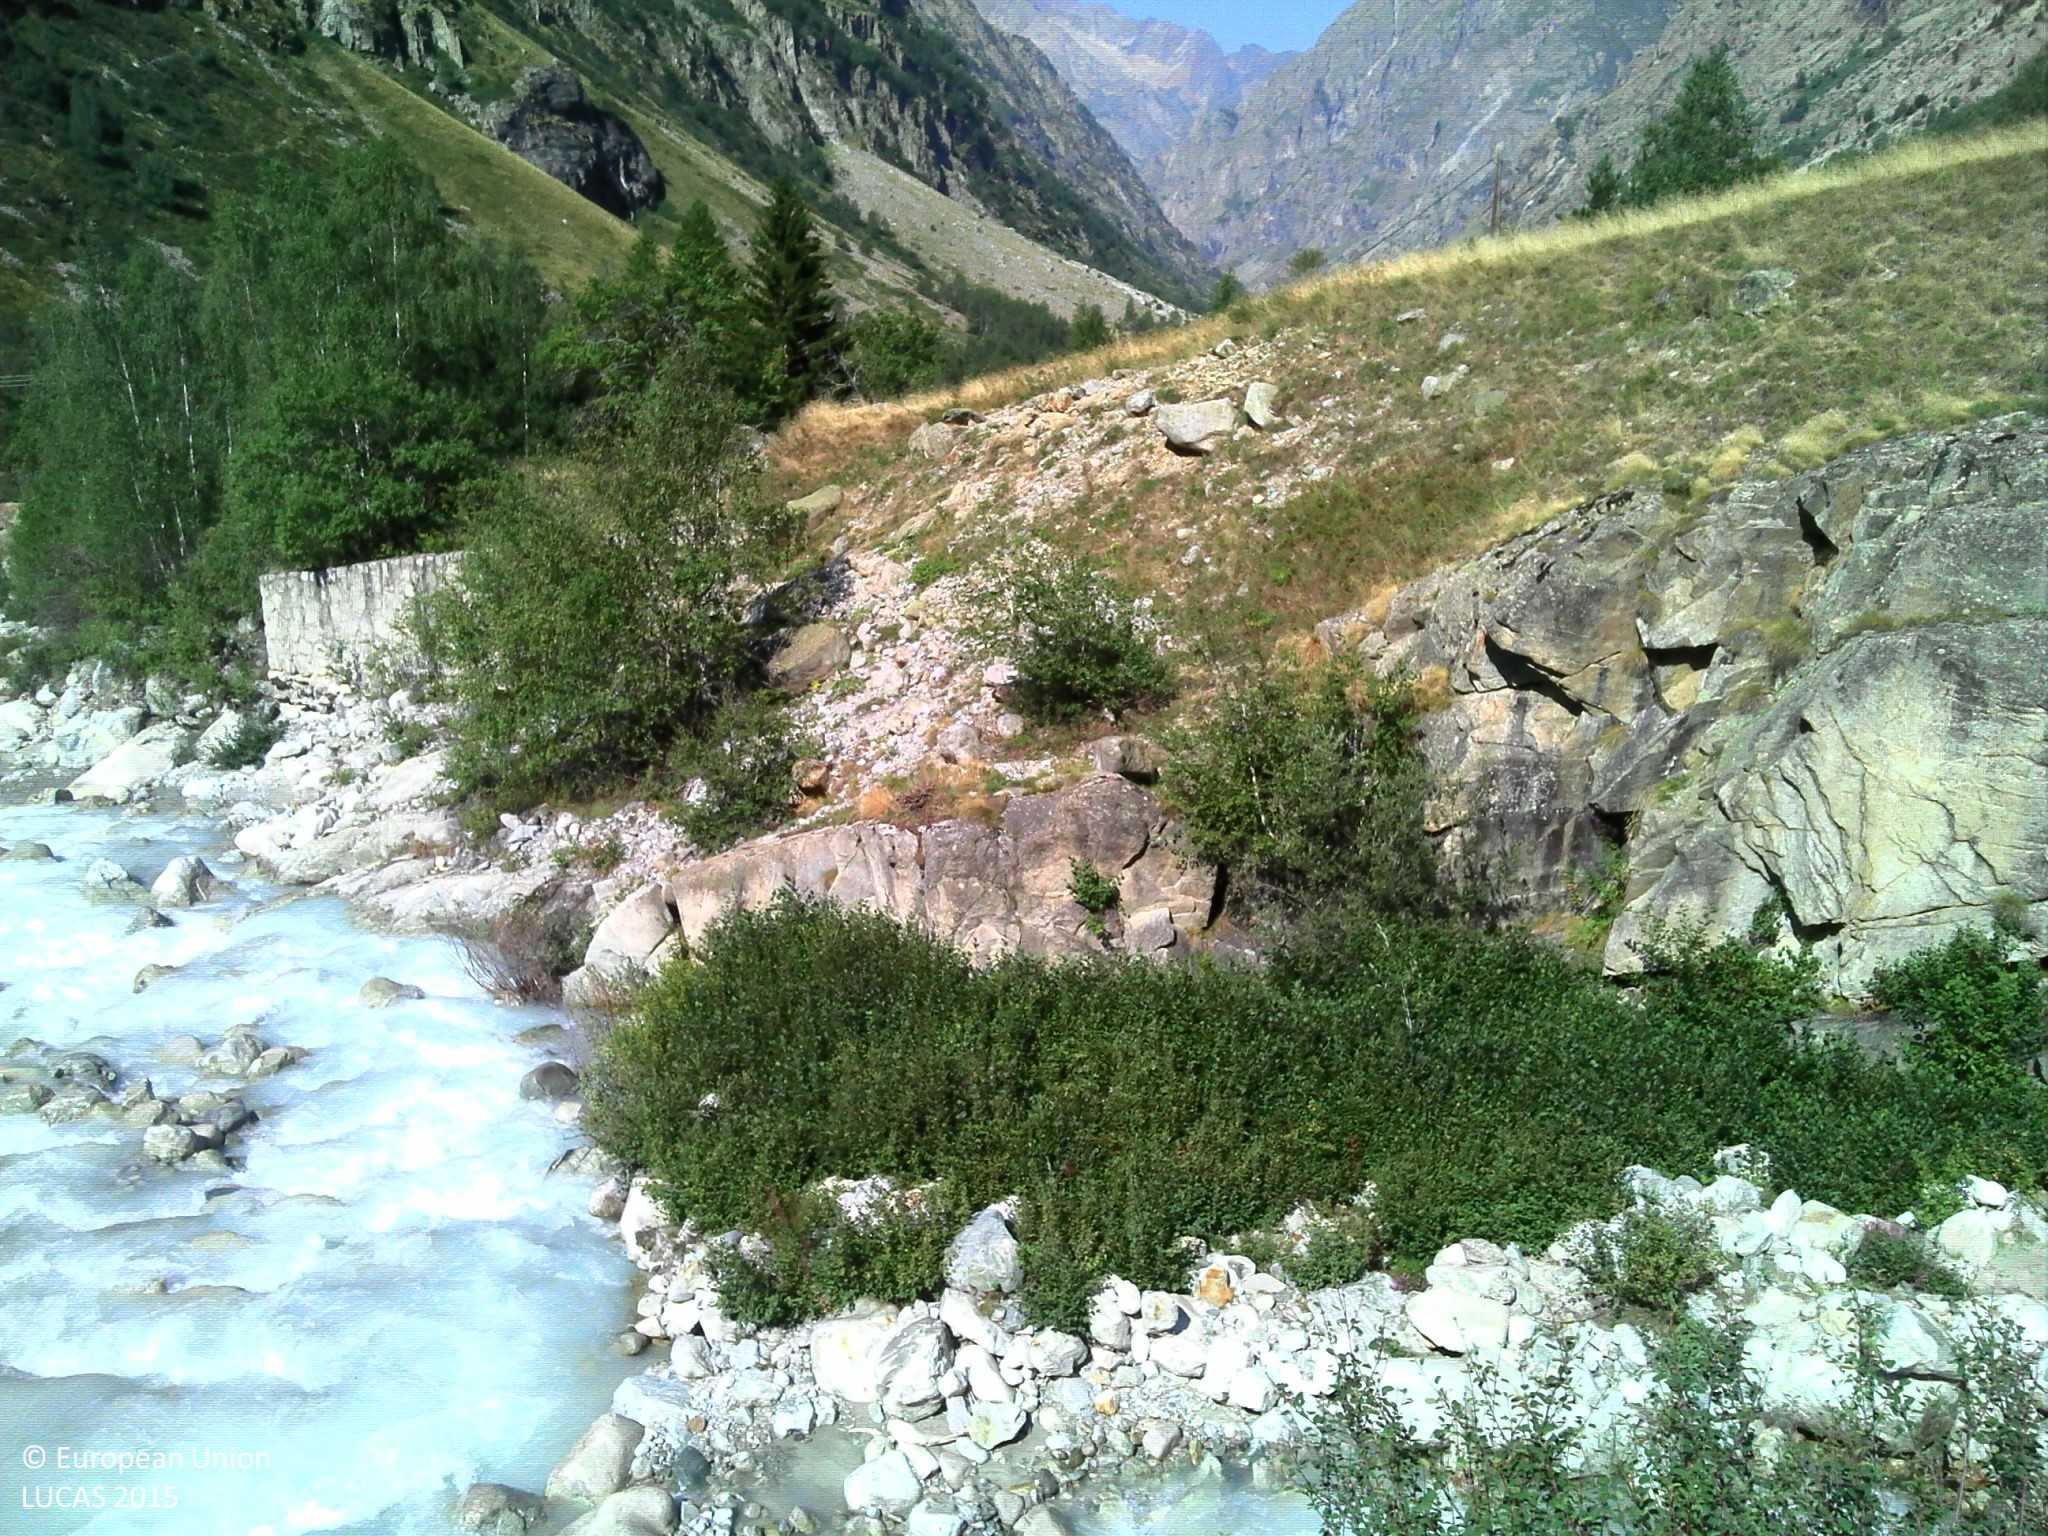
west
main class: Grassland
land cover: Grassland without tree/shrub cover
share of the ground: > 75 %
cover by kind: herbaceous plants 90 %, shrubs 5 %, unconsolidated bare surface 5 %
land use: Semi-natural and natural areas not in use
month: August
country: FR
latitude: 44.9342
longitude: 6.2930
